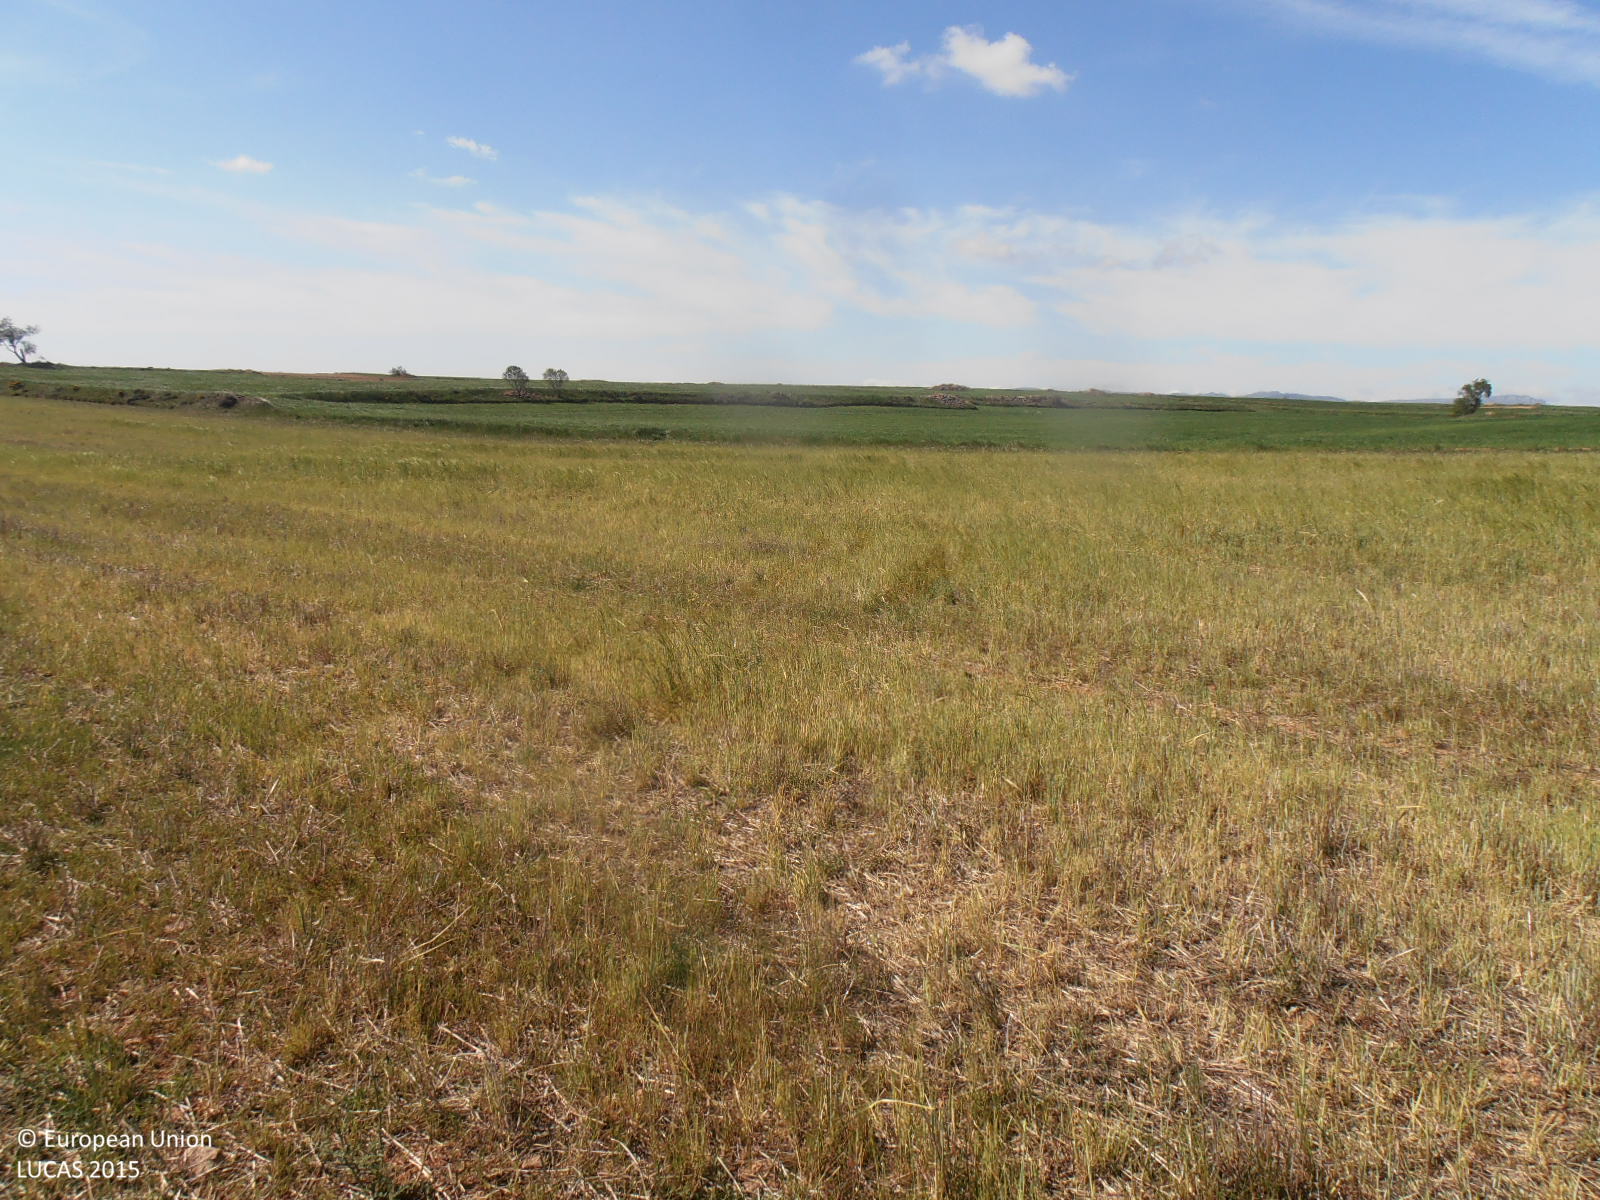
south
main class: Grassland
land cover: Spontaneously vegetated surfaces
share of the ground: > 75 %
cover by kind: herbaceous plants 100 %
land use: Agriculture (excluding fallow land and kitchen gardens)
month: April
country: ES
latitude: 41.1994
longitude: -0.9769
